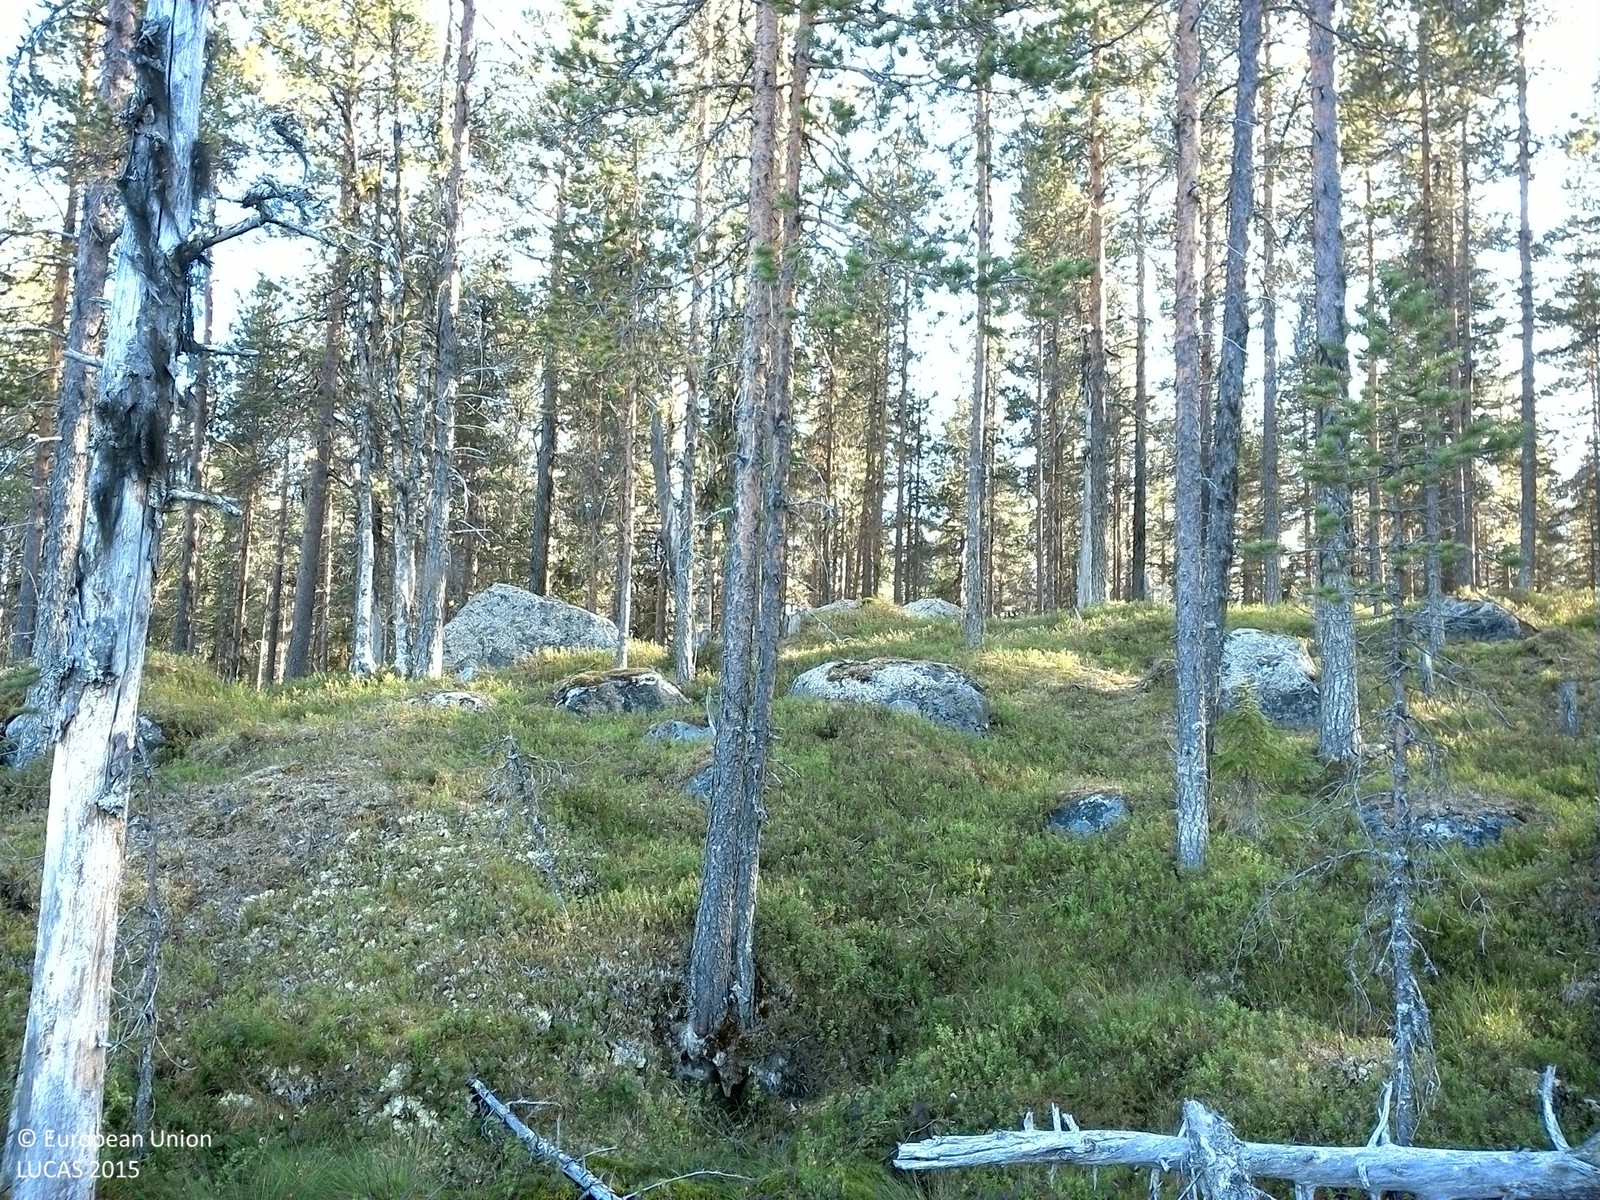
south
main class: Woodland
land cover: Broadleaved woodland
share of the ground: 25 - 50 %
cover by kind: broadleaved forest trees 40 %, herbaceous plants 30 %, lichens and mosses 25 %, shrubs 5 %
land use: Semi-natural and natural areas not in use
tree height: < 5 m
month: August
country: SE
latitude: 64.0918
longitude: 17.5394
